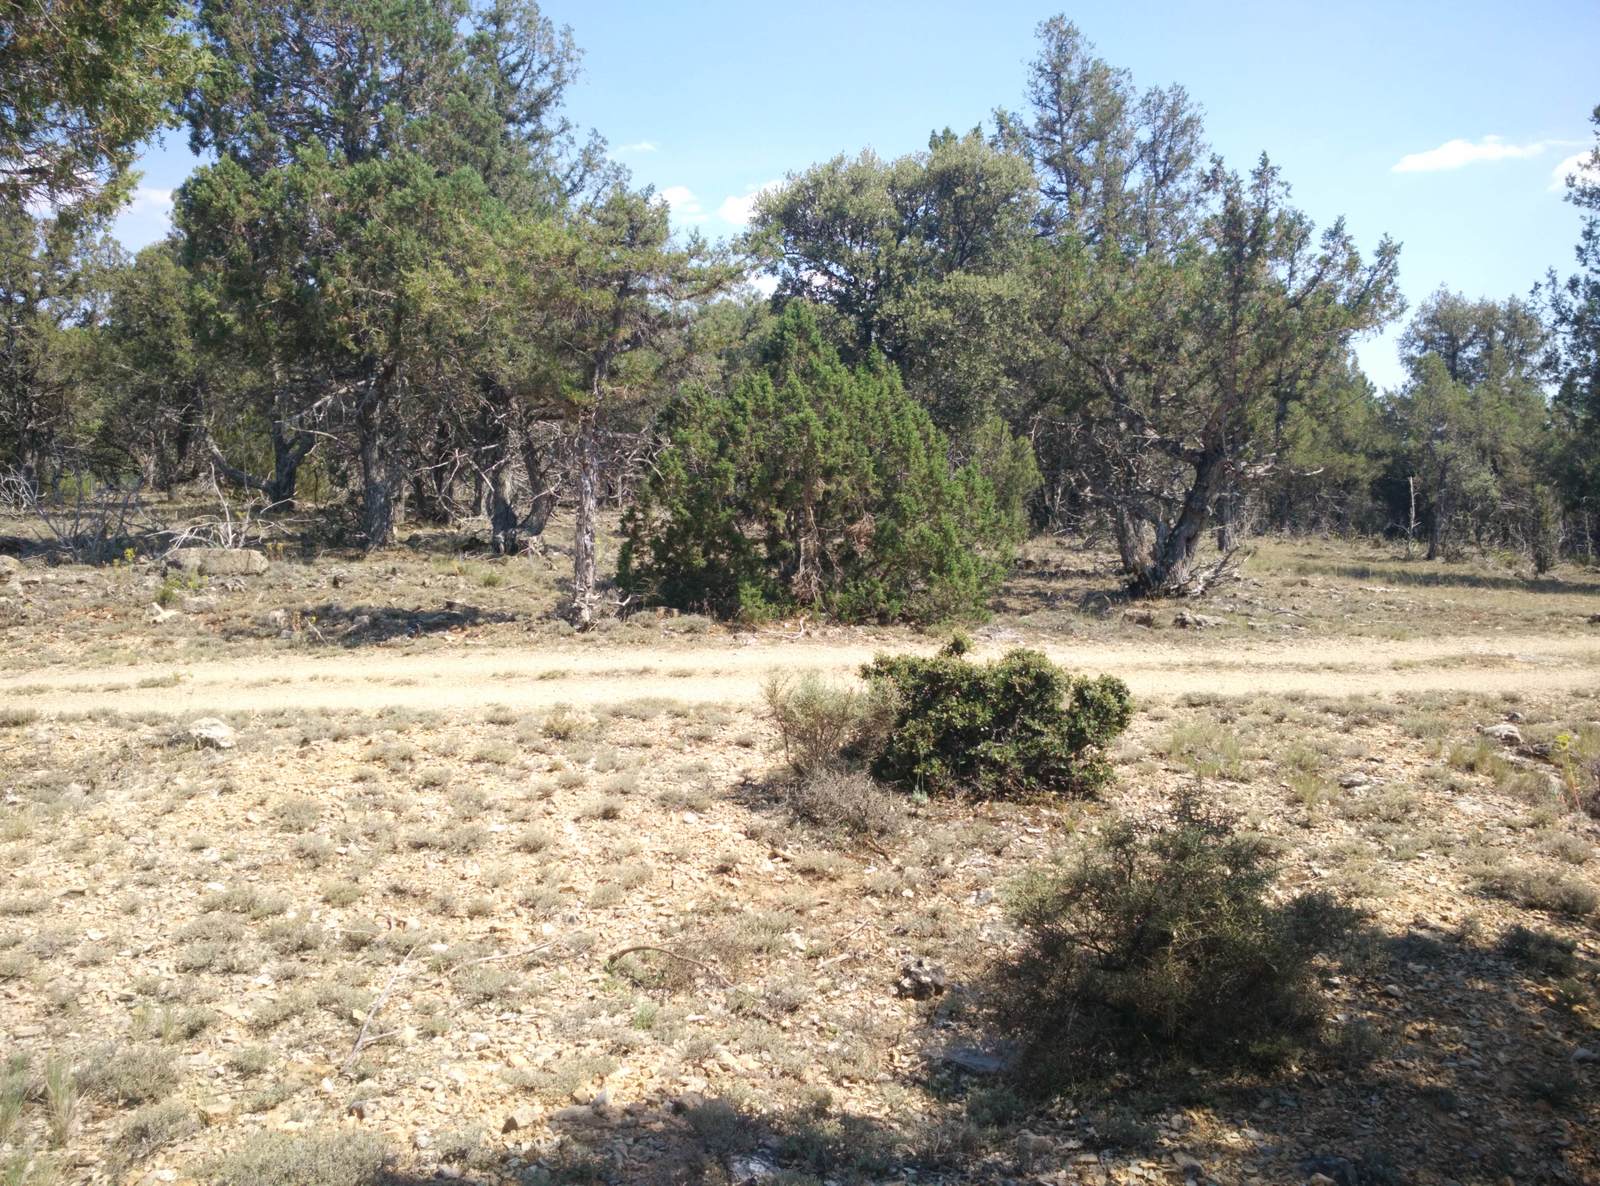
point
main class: Woodland
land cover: Pine dominated coniferous woodland
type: coniferous forest of the mediterranean region
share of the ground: 50 - 75 %
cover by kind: coniferous forest trees 50 %, unconsolidated bare surface 35 %, shrubs 10 %, broadleaved forest trees 5 %
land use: Semi-natural and natural areas not in use
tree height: > 5 m
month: July
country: ES
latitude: 40.8476
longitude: -2.1109
